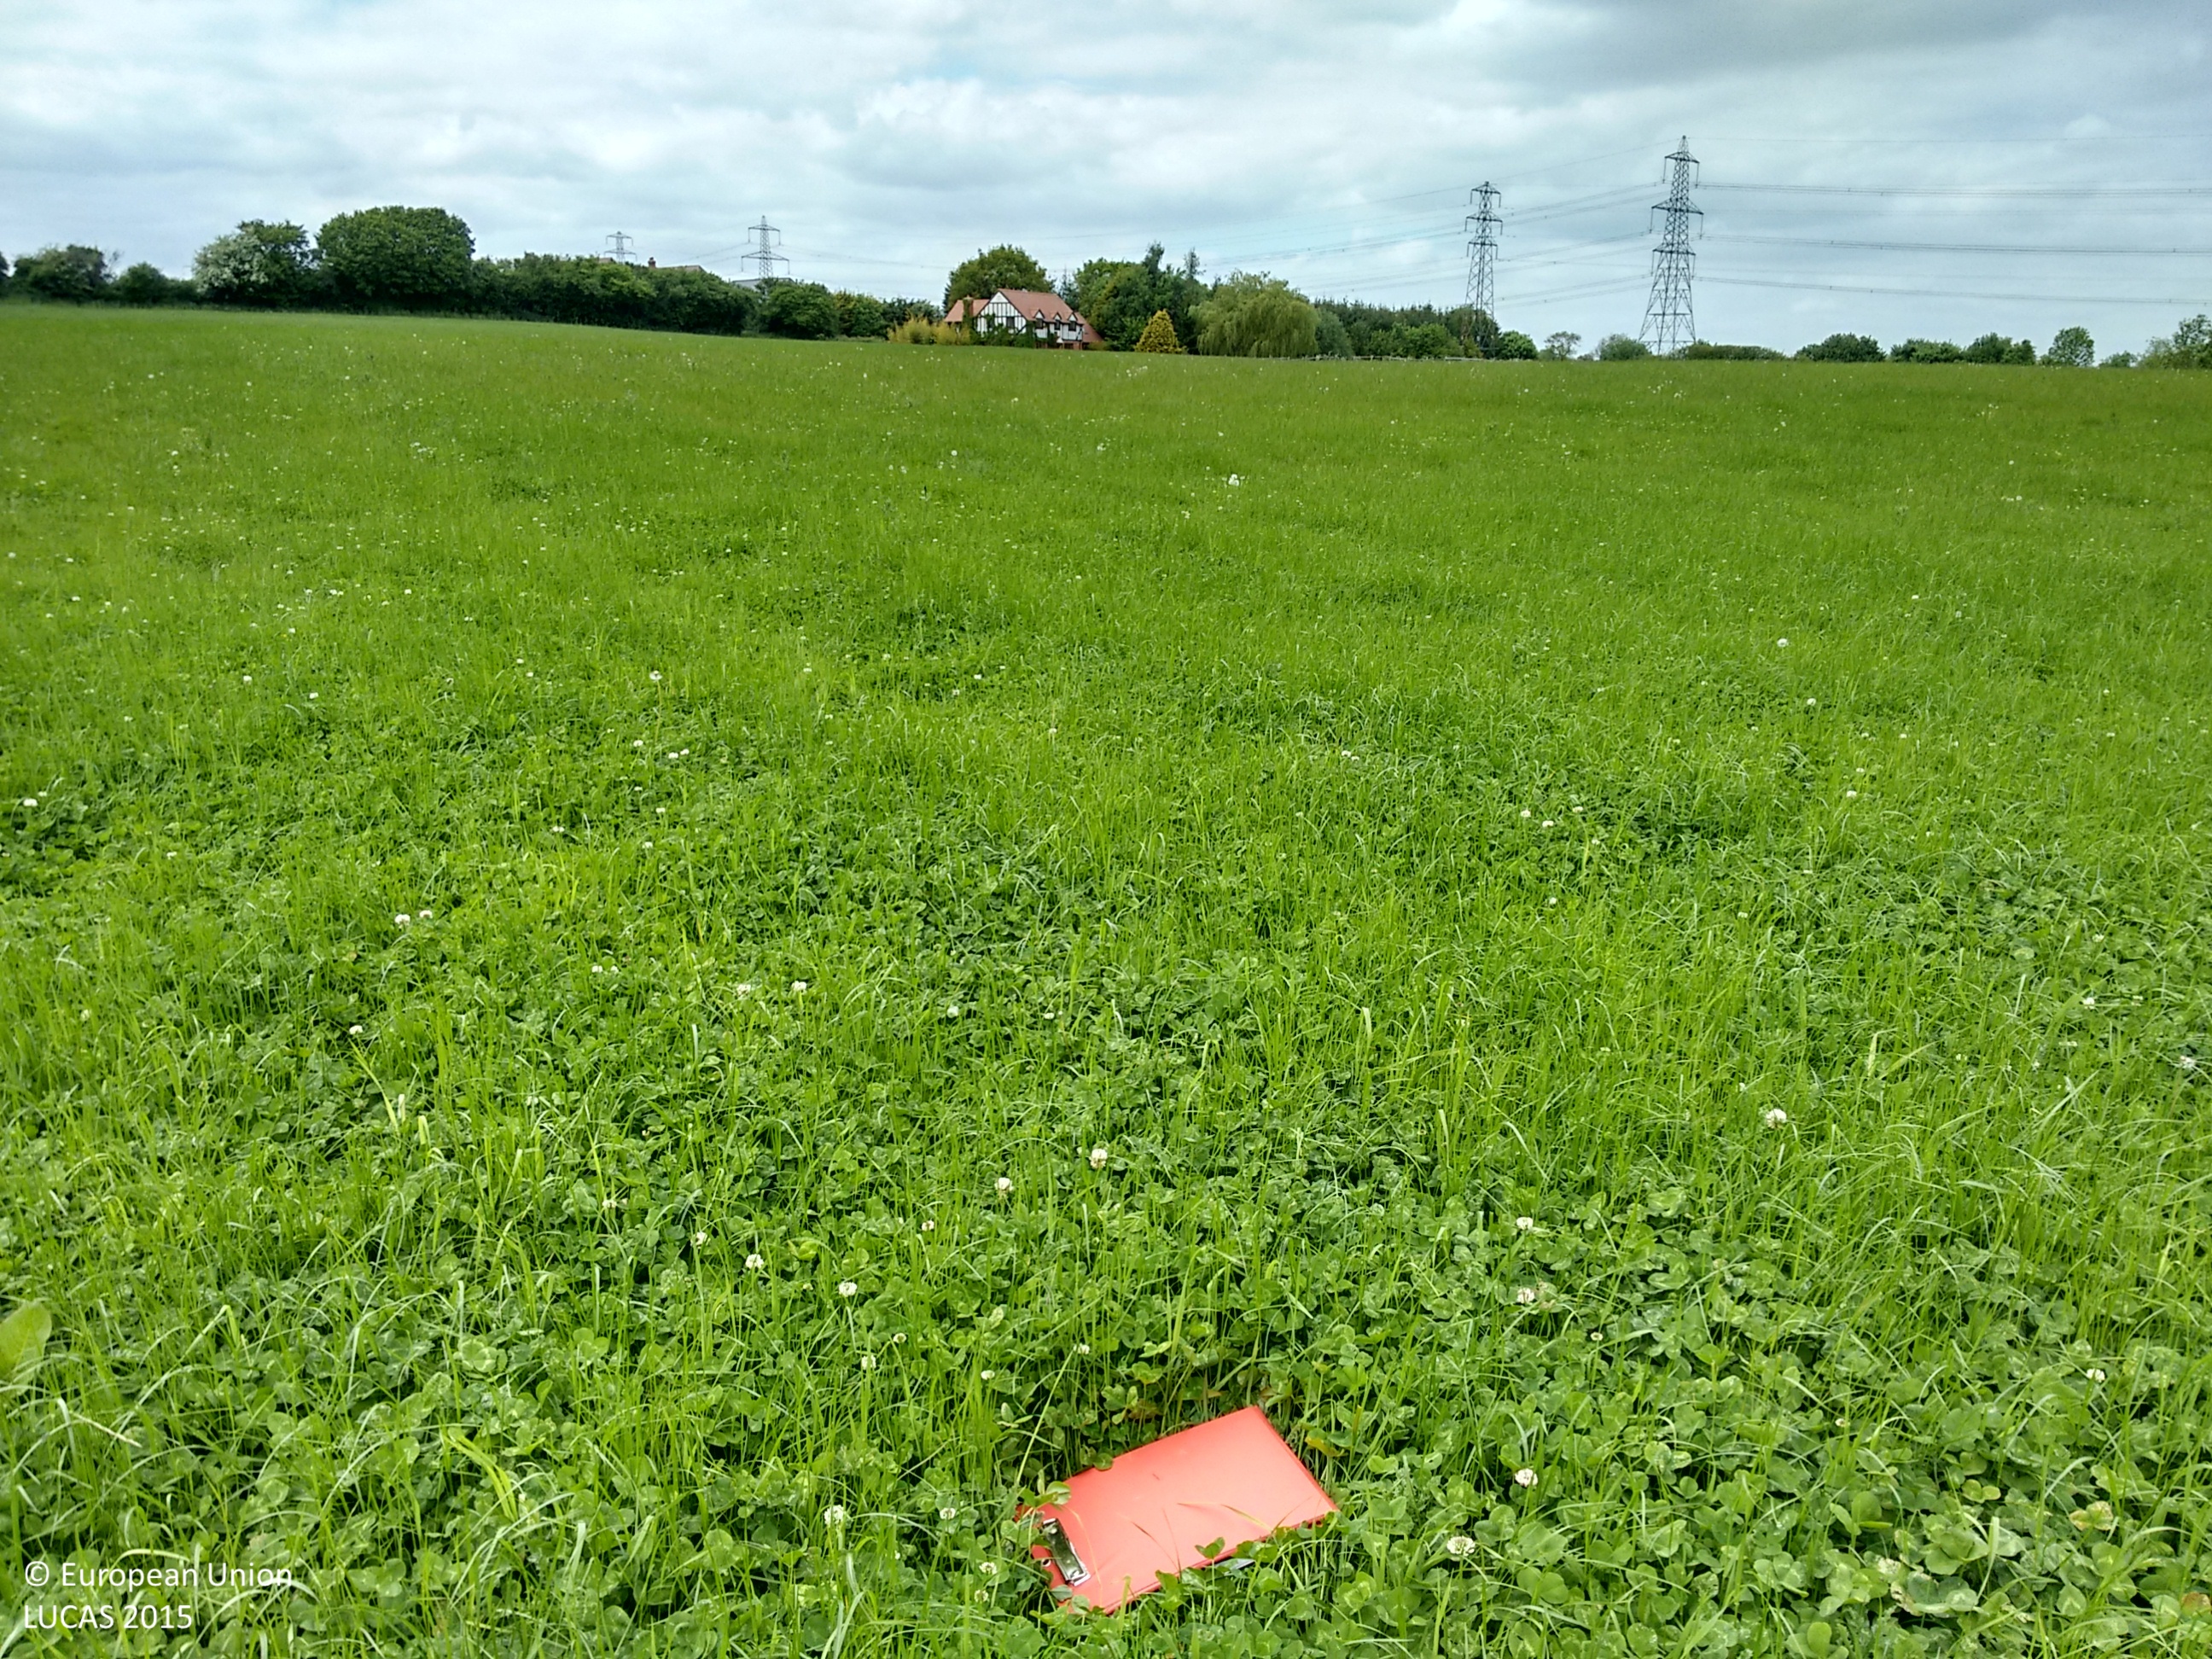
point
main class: Cropland
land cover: Other leguminous and mixtures for fodder
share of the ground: > 75 %
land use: Agriculture (excluding fallow land and kitchen gardens)
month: May
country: GB
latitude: 51.9566
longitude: 0.0287
